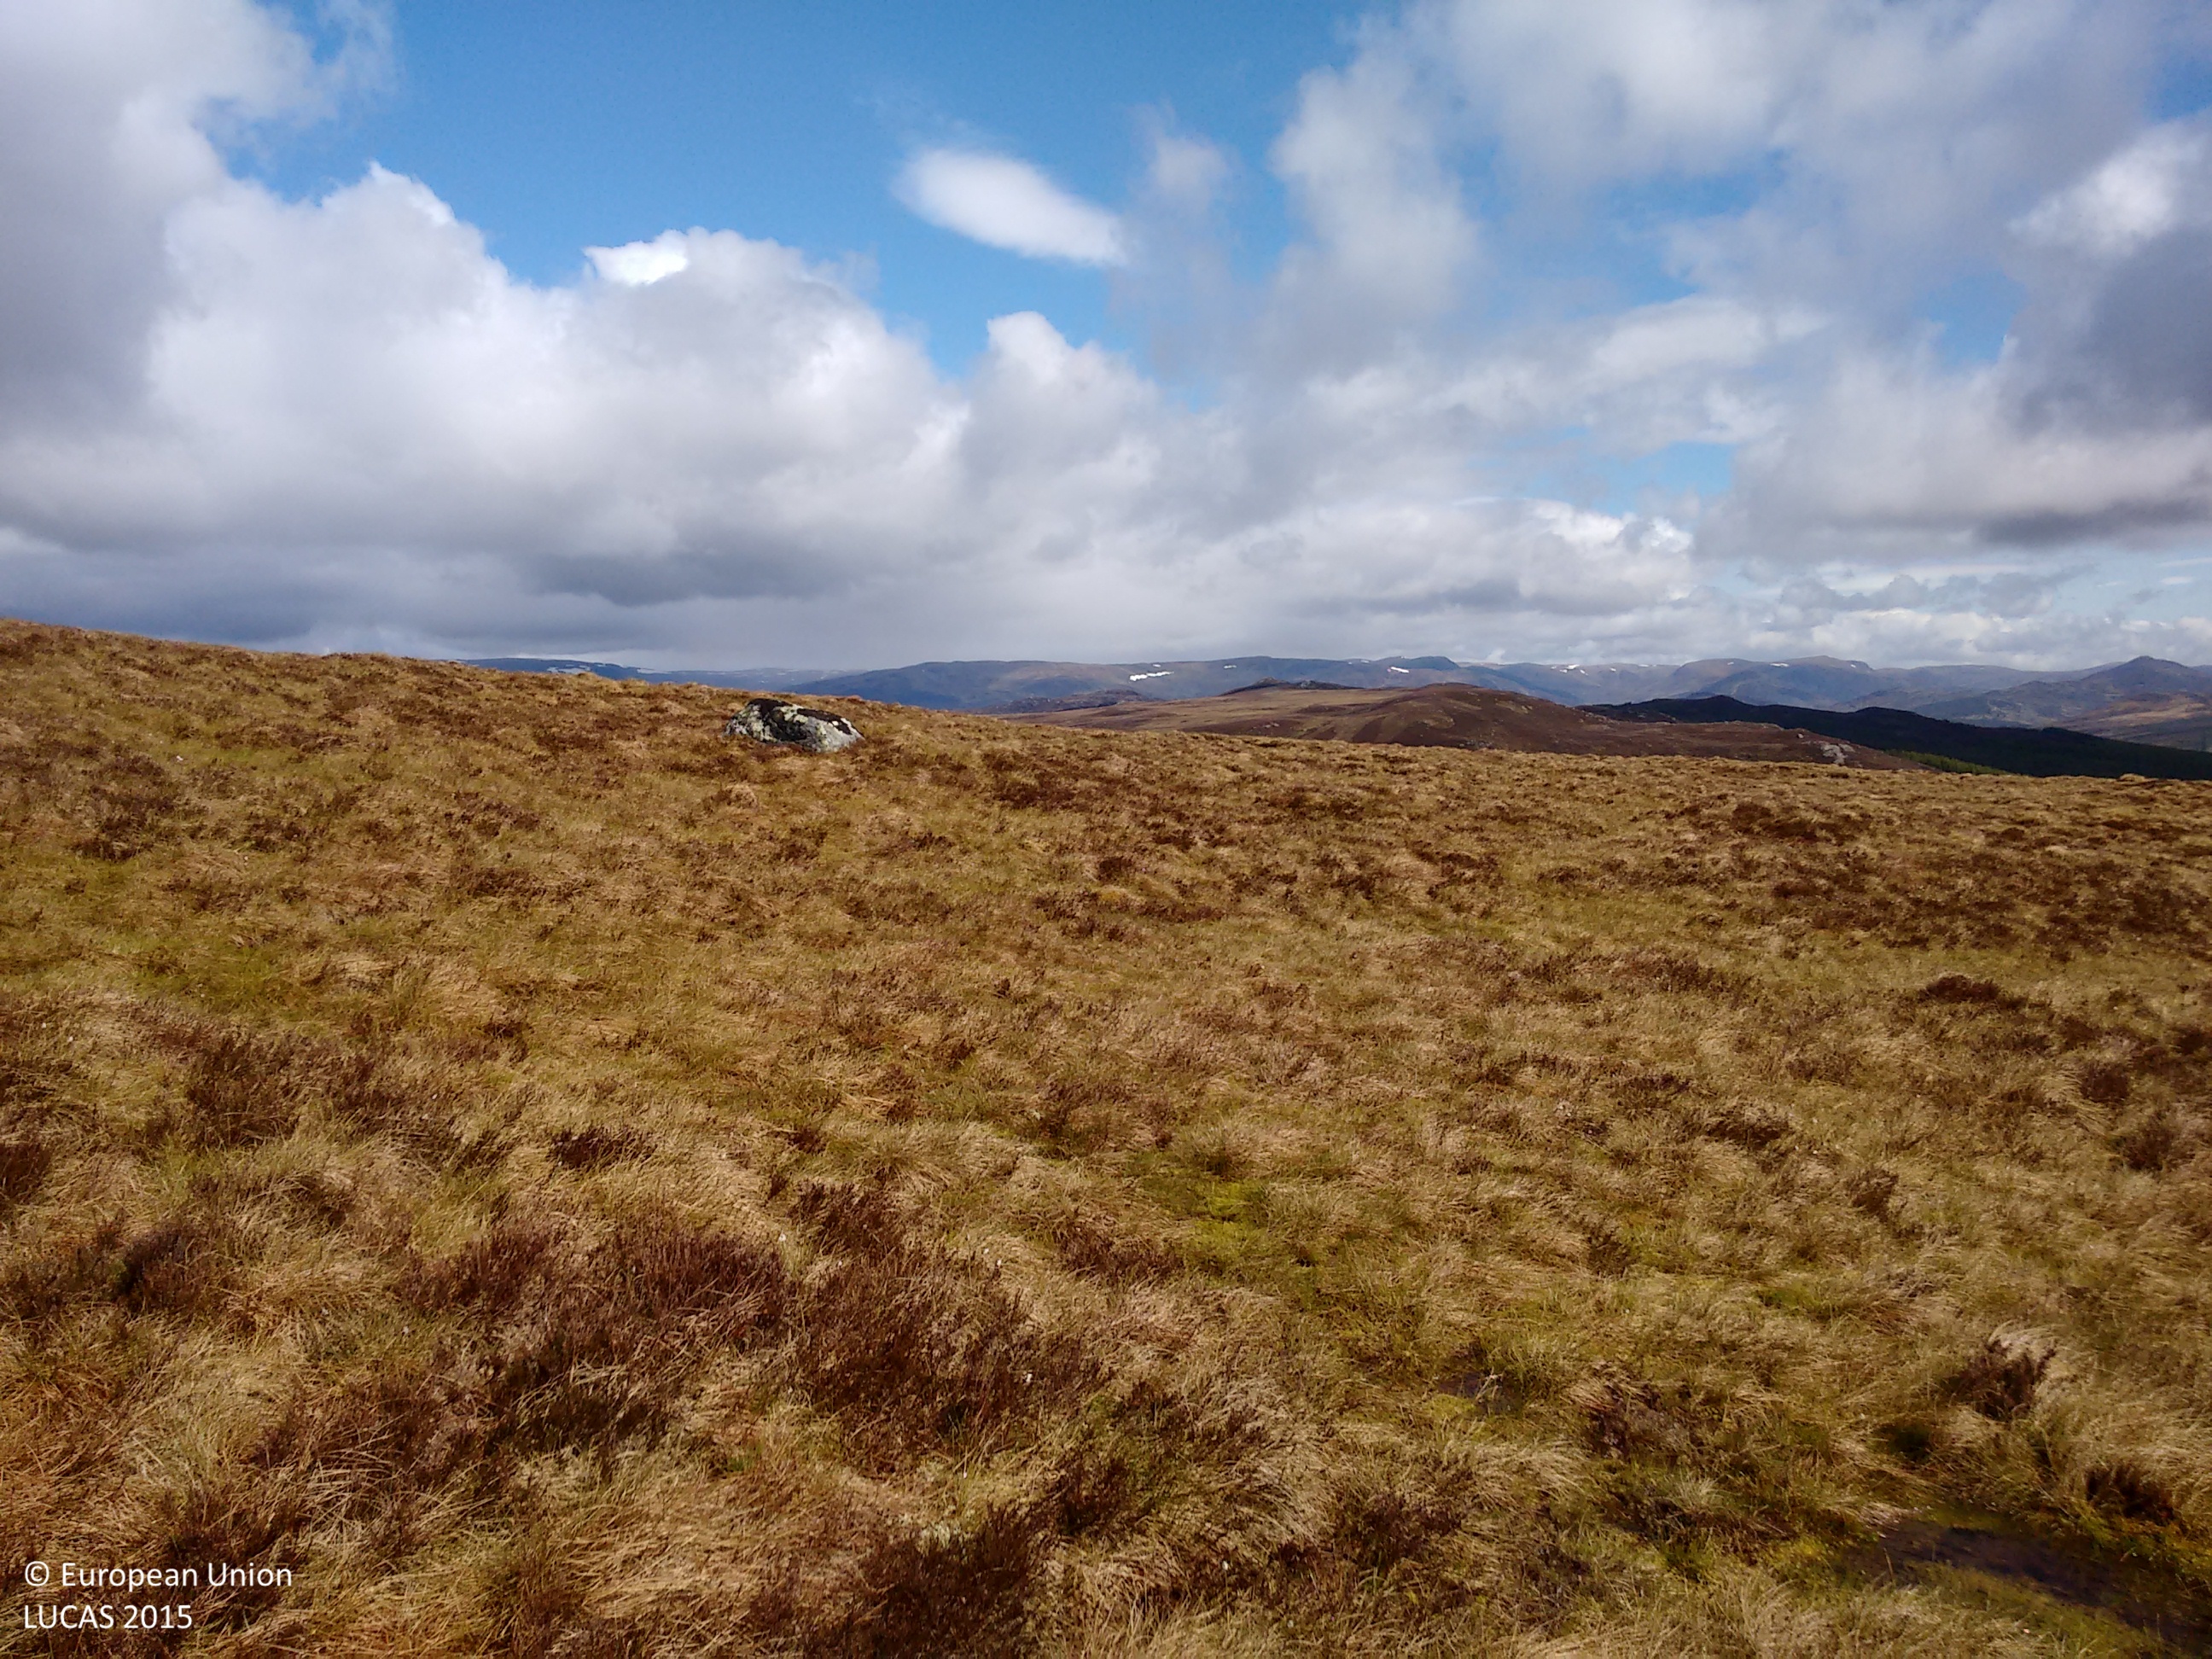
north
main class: Shrubland
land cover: Shrubland without tree cover
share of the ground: > 75 %
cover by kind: shrubs 50 %, herbaceous plants 40 %, lichens and mosses 10 %
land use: Agriculture (excluding fallow land and kitchen gardens)
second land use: Other primary production
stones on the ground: < 10 %
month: June
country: GB
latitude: 56.9394
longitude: -4.2732
